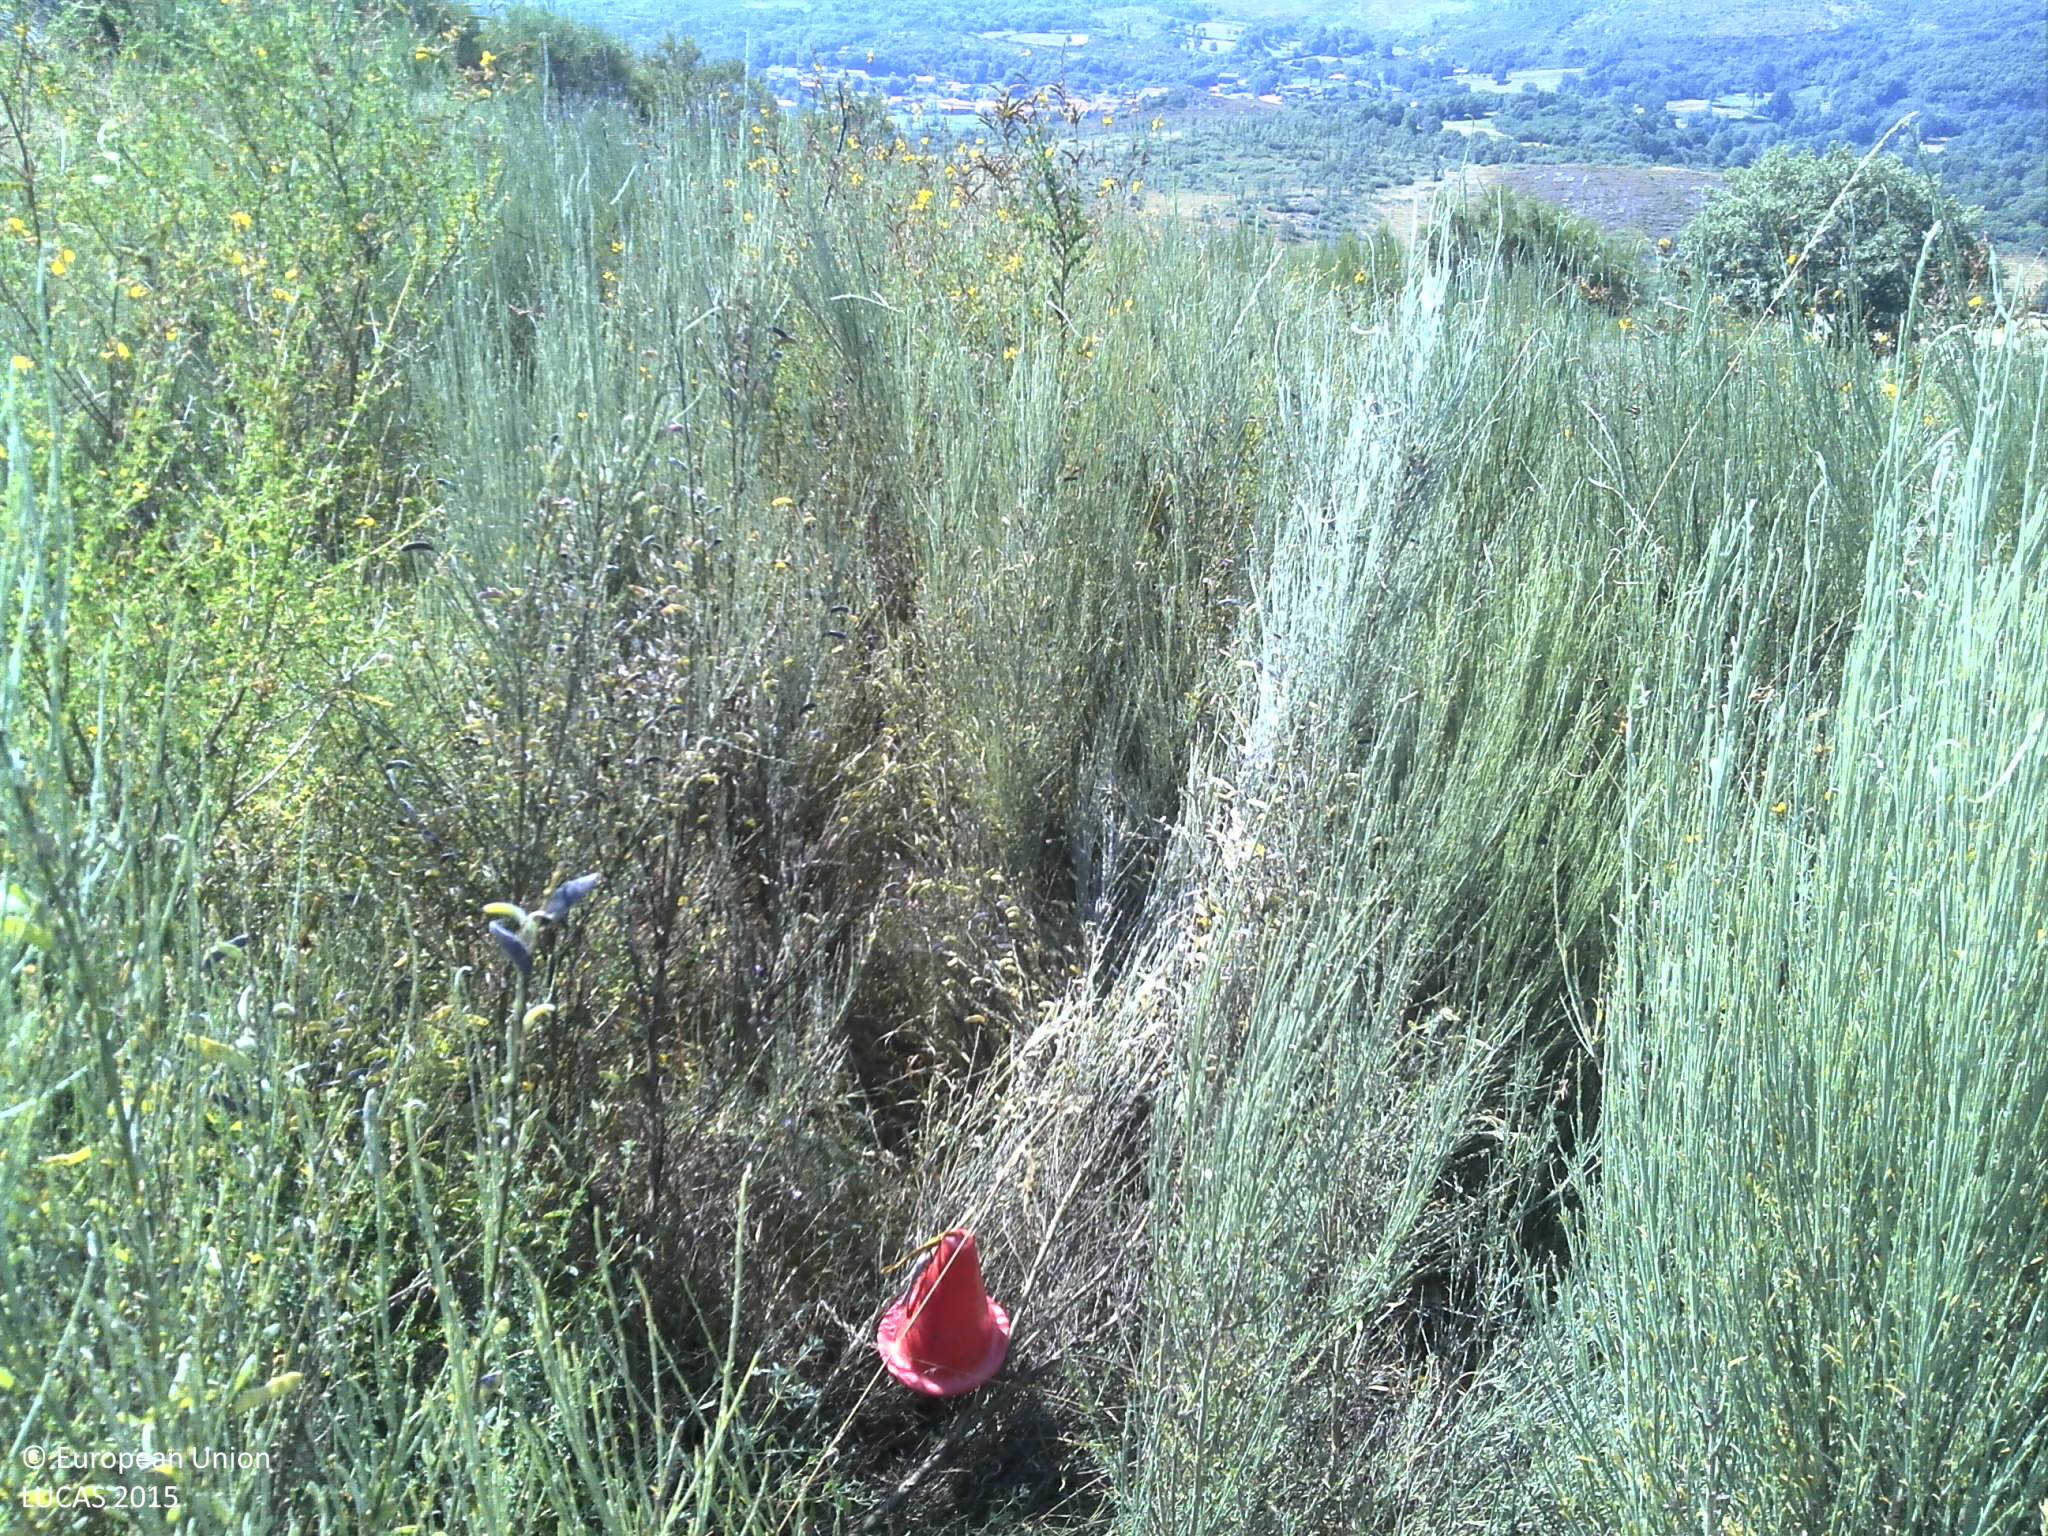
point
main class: Shrubland
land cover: Shrubland without tree cover
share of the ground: > 75 %
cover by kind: shrubs 90 %, herbaceous plants 5 %, unconsolidated bare surface 5 %
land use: Agriculture (excluding fallow land and kitchen gardens)
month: July
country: PT
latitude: 41.8101
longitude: -7.8480
